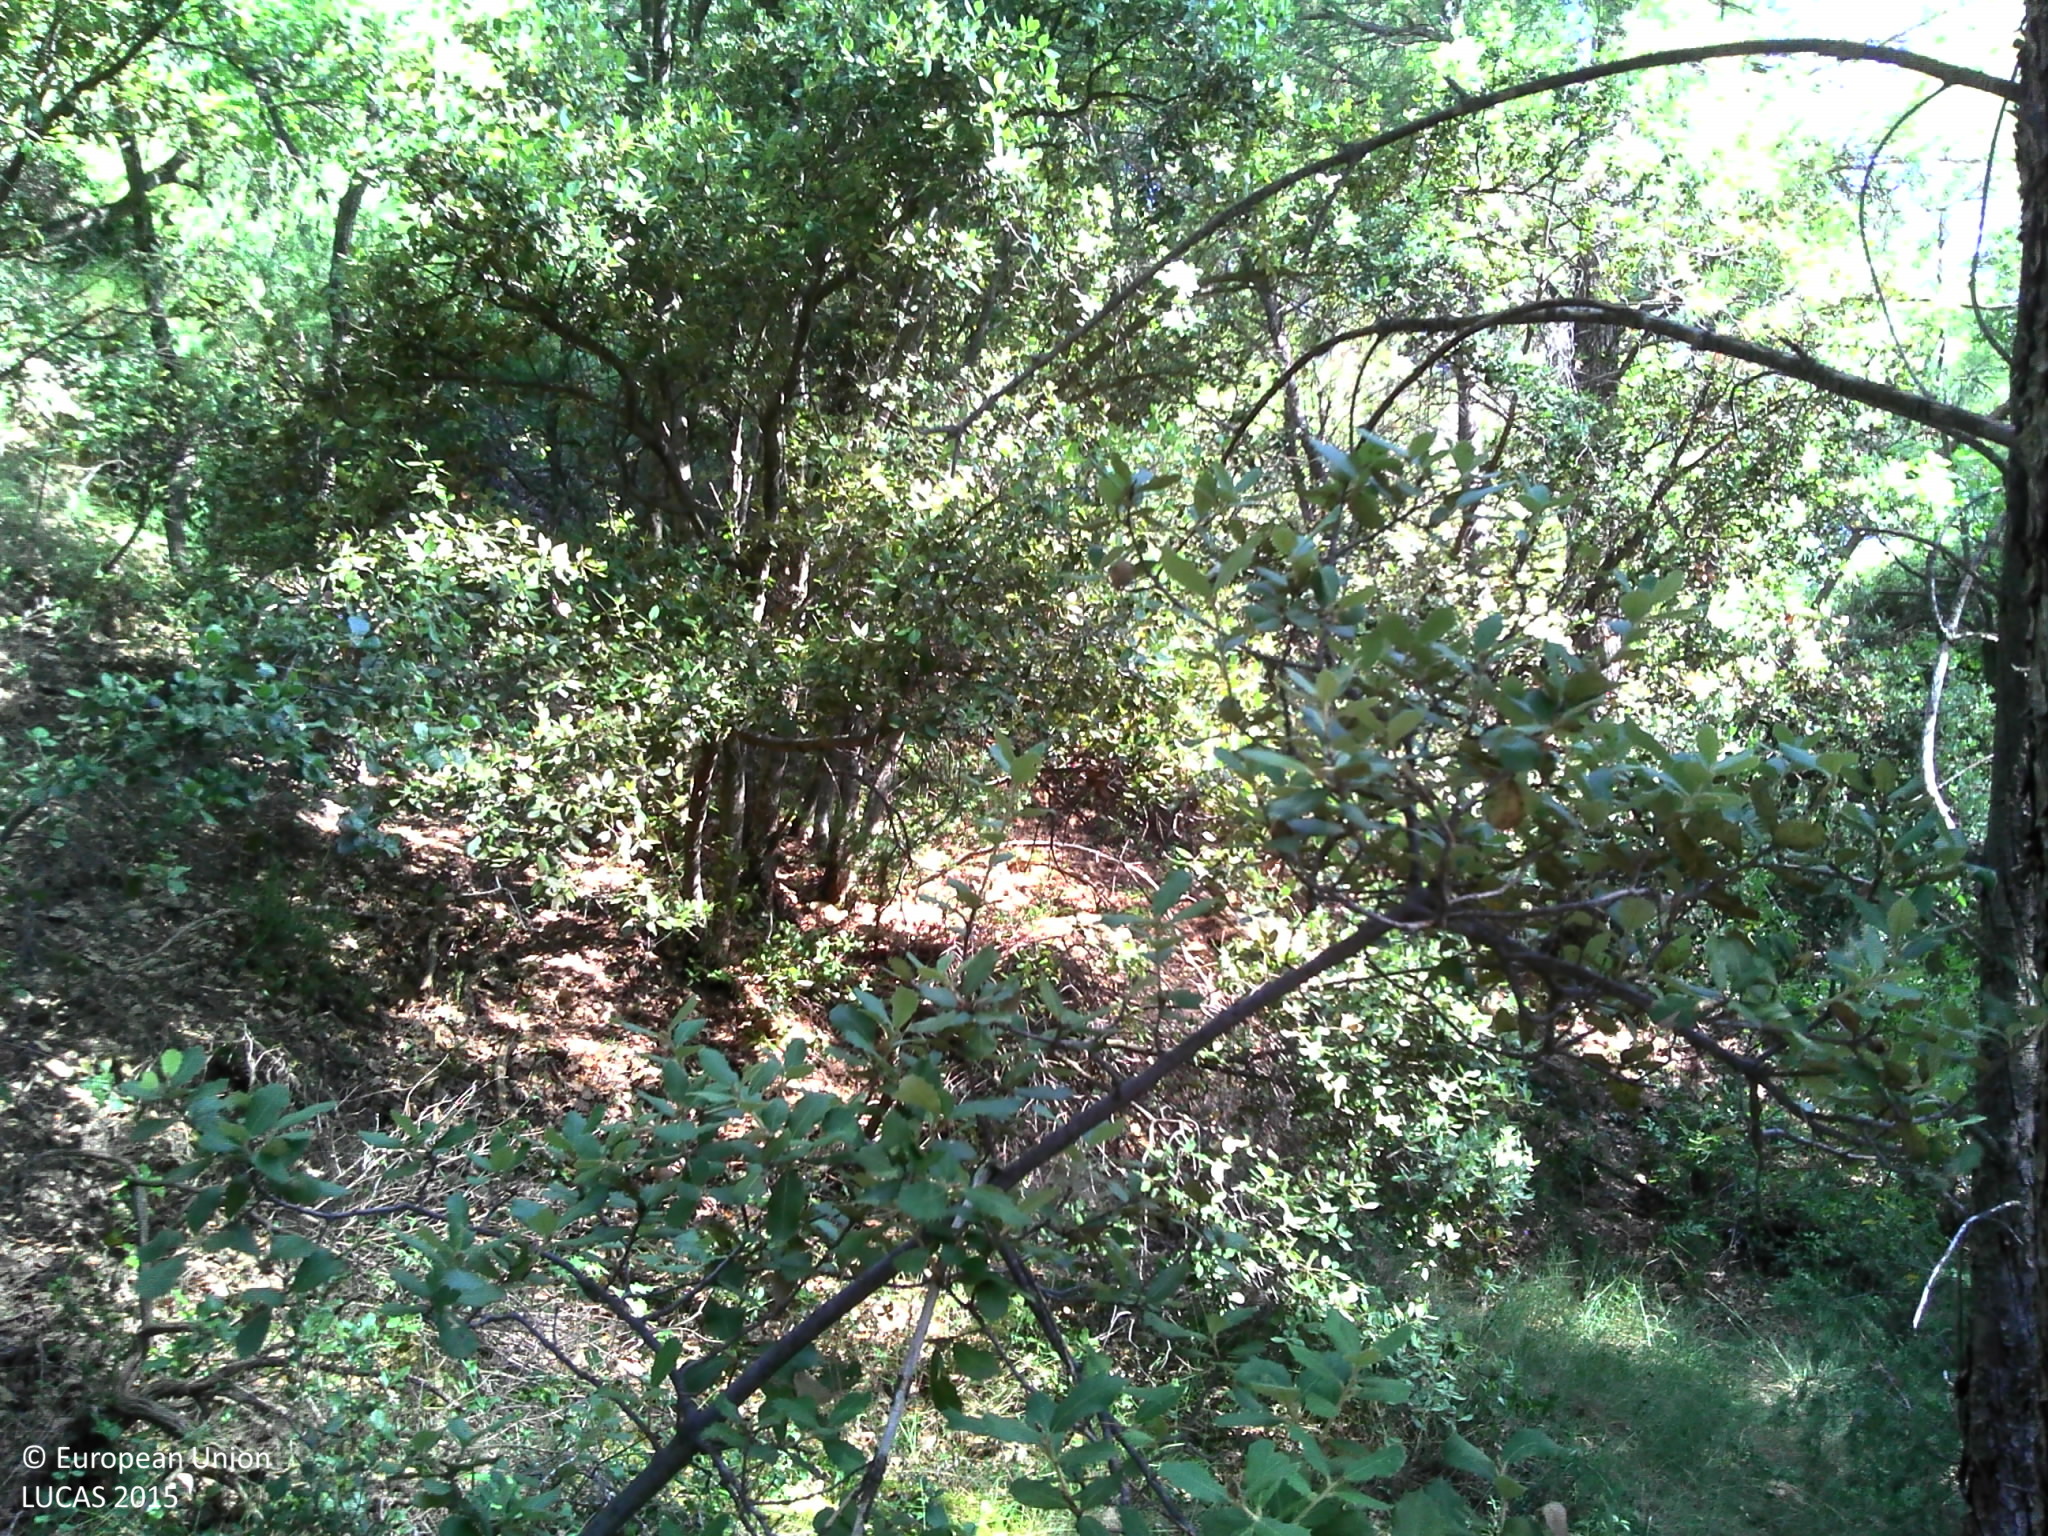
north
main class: Woodland
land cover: Pine dominated mixed woodland
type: mesophytic deciduous forest
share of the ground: > 75 %
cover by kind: coniferous forest trees 40 %, broadleaved forest trees 30 %, shrubs 10 %, herbaceous plants 10 %, lichens and mosses 10 %
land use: Semi-natural and natural areas not in use
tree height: > 5 m
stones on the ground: < 10 %
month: July
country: FR
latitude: 44.1611
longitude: 5.0686
